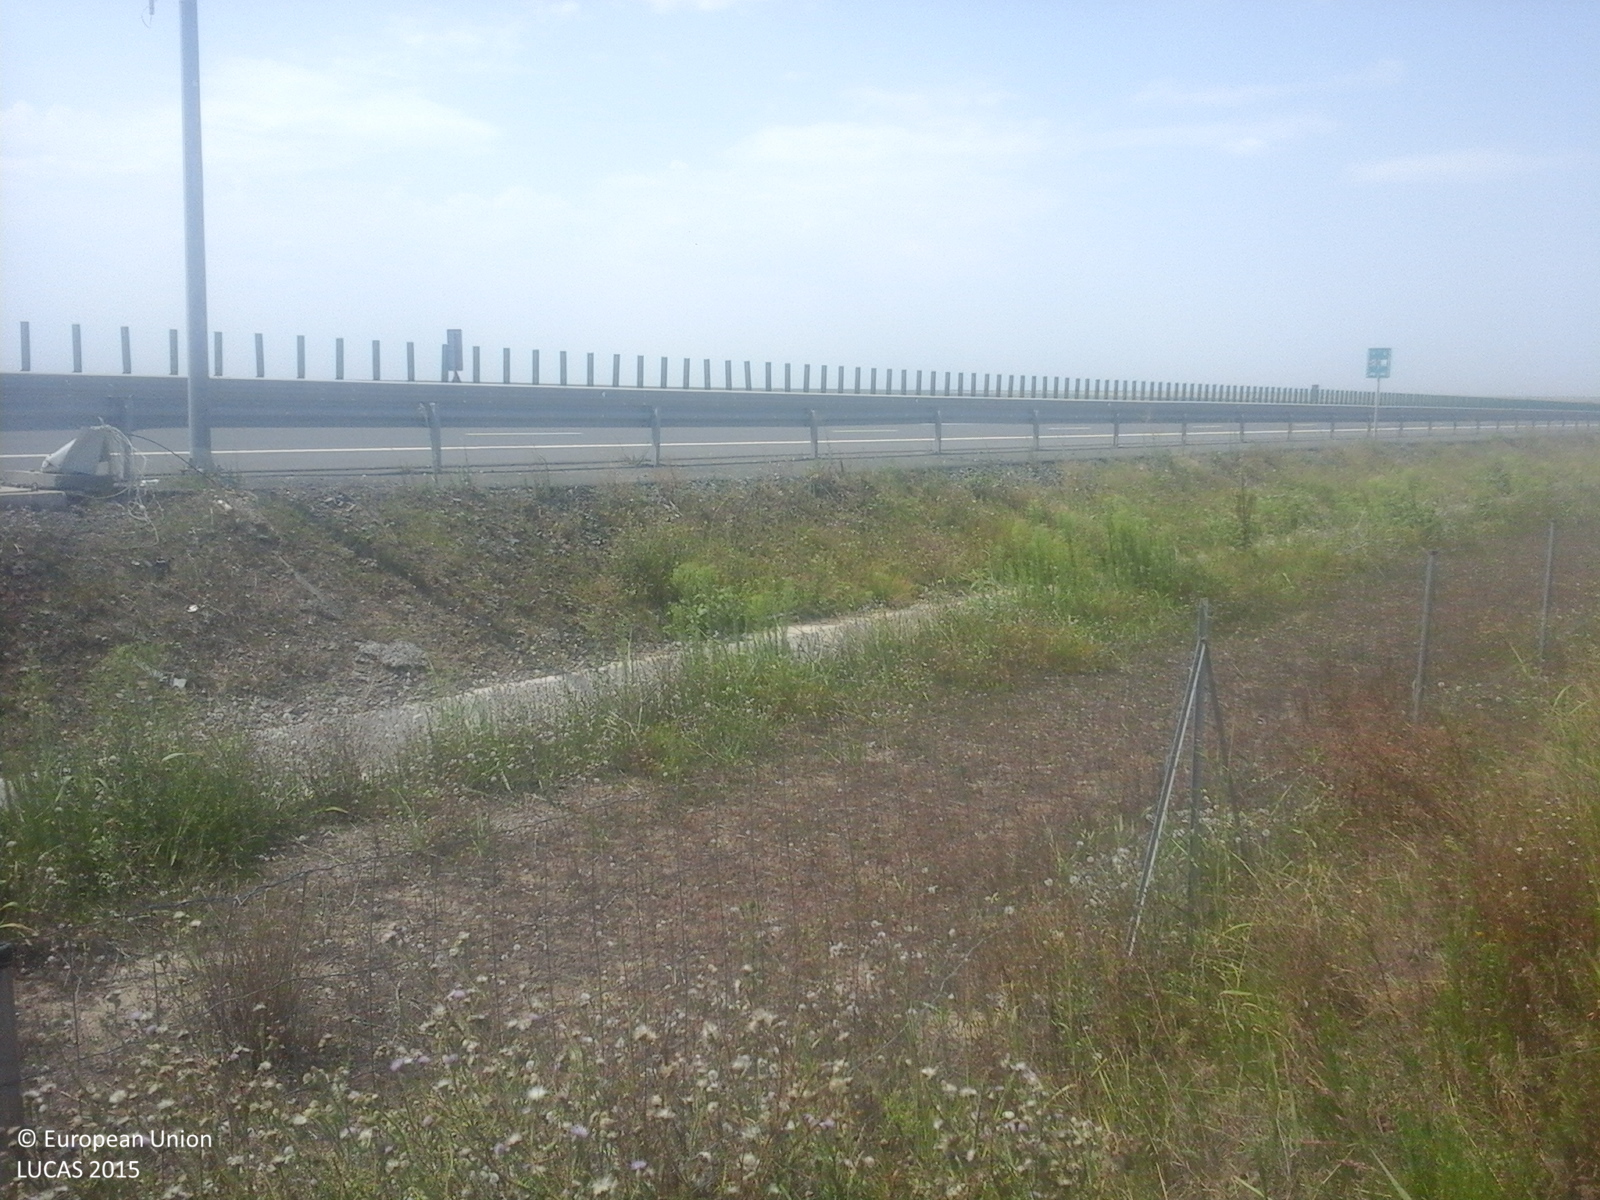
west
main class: Cropland
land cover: Sunflower
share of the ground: > 75 %
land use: Agriculture (excluding fallow land and kitchen gardens)
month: August
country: RO
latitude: 44.1801
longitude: 28.3141
